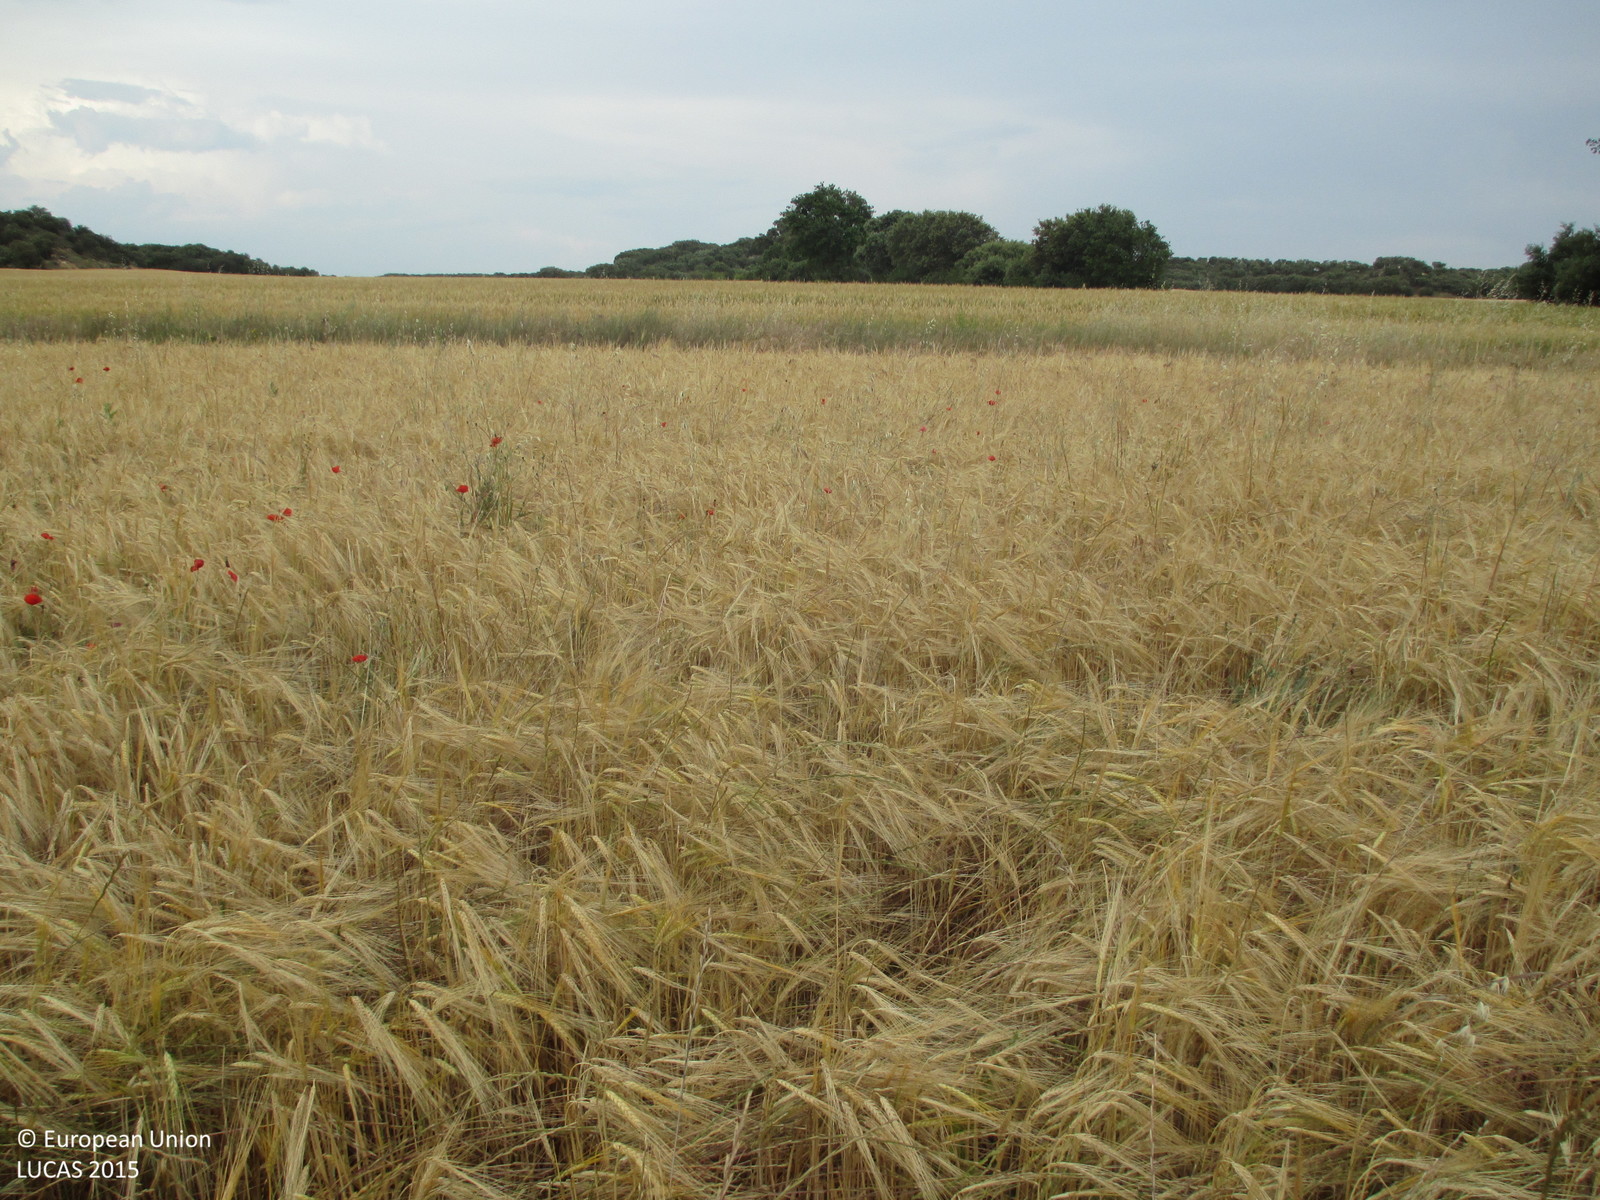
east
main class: Cropland
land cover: Barley
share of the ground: > 75 %
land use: Agriculture (excluding fallow land and kitchen gardens)
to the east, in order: Barley; Shruby margins; Tracks; Shruby margins; Common wheat; Lines of trees; Shruby margins; Tracks; Grassland with sparse tree/shrub cover; Barley
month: May
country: ES
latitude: 42.1308
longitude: -0.2682
